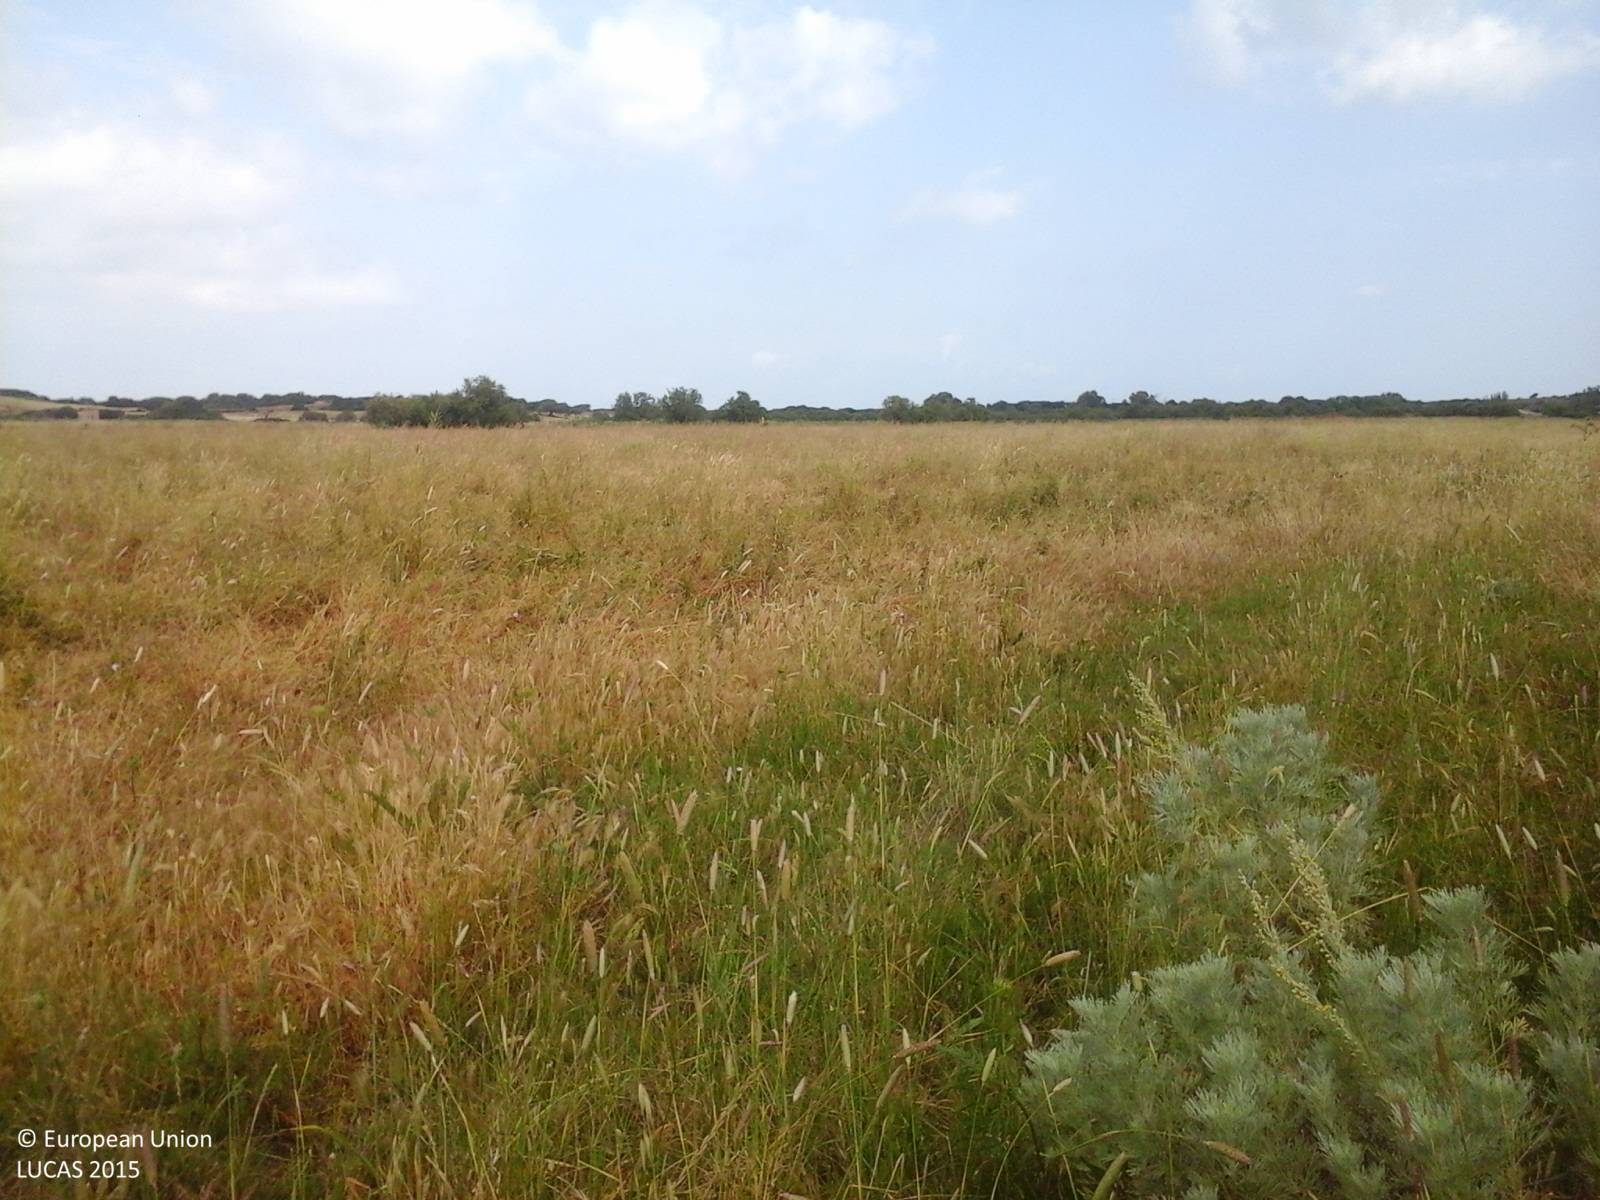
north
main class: Grassland
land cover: Spontaneously vegetated surfaces
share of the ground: > 75 %
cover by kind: herbaceous plants 100 %
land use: Agriculture (excluding fallow land and kitchen gardens)
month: May
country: IT
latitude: 40.9483
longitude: 8.8531
